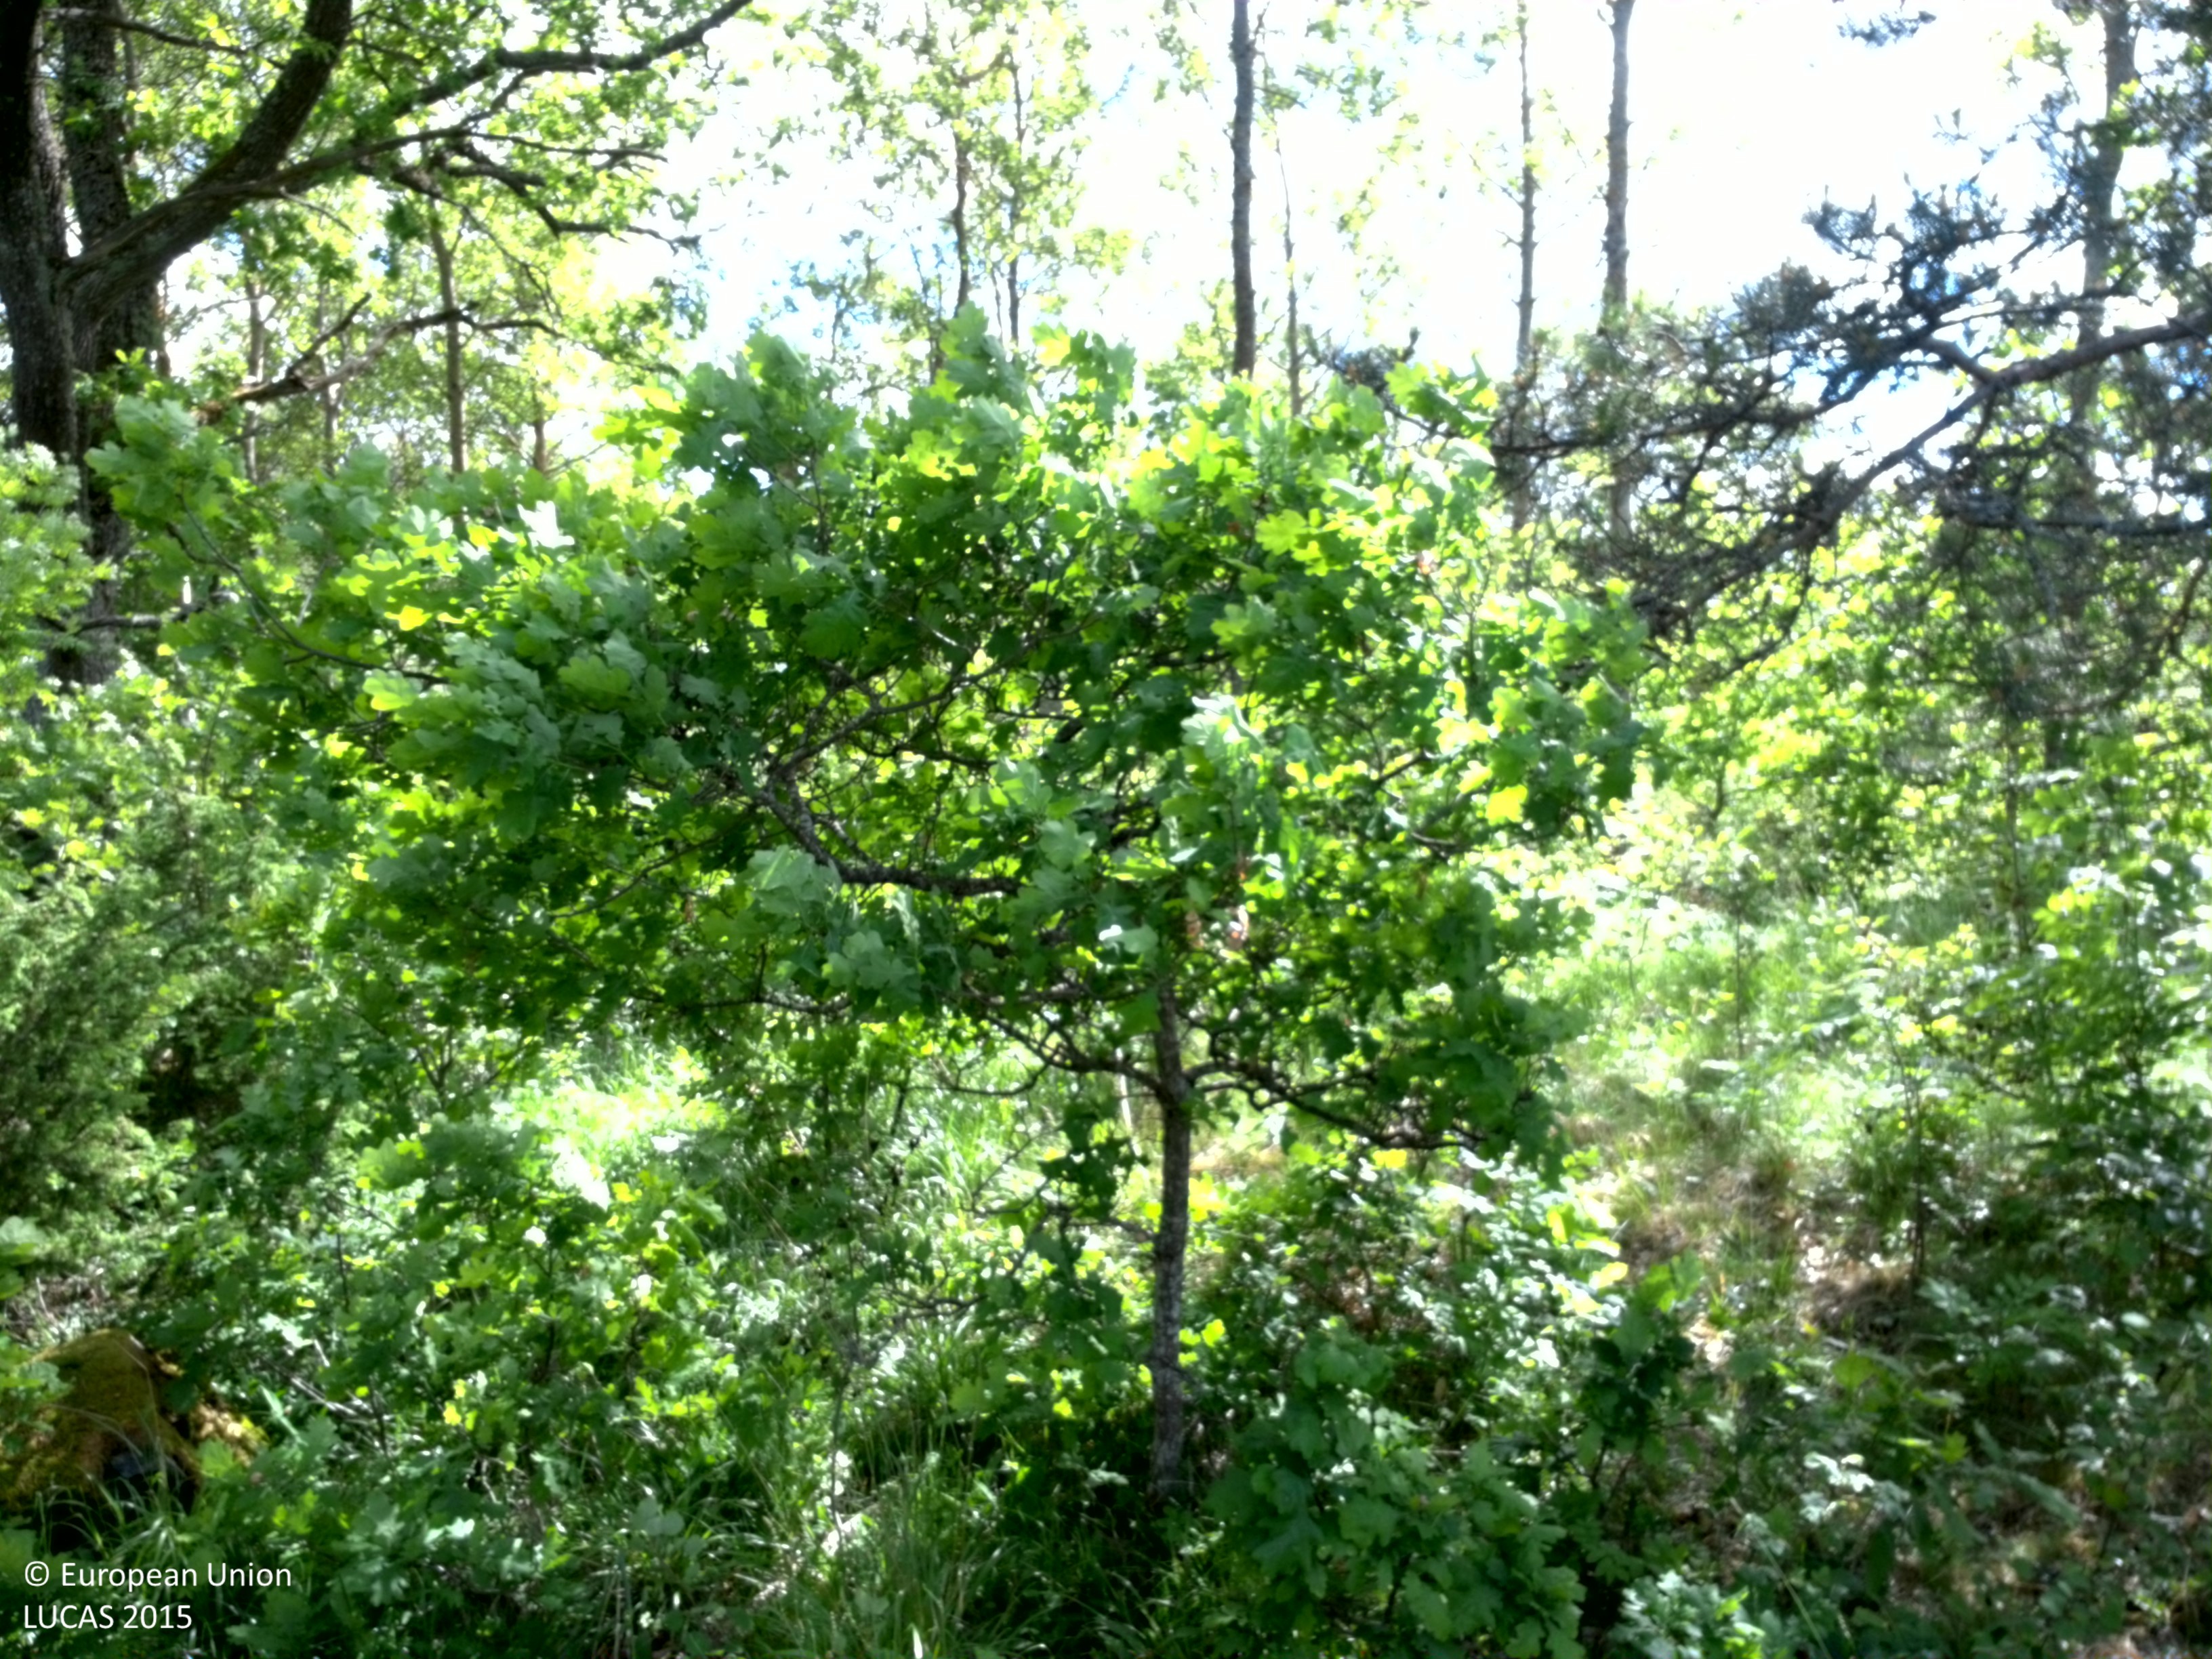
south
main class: Woodland
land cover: Broadleaved woodland
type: boreal forest
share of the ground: 25 - 50 %
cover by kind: broadleaved forest trees 40 %, herbaceous plants 30 %, coniferous forest trees 10 %, shrubs 10 %, lichens and mosses 10 %
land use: Forestry
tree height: > 5 m
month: June
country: SE
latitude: 59.8877
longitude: 17.5528
